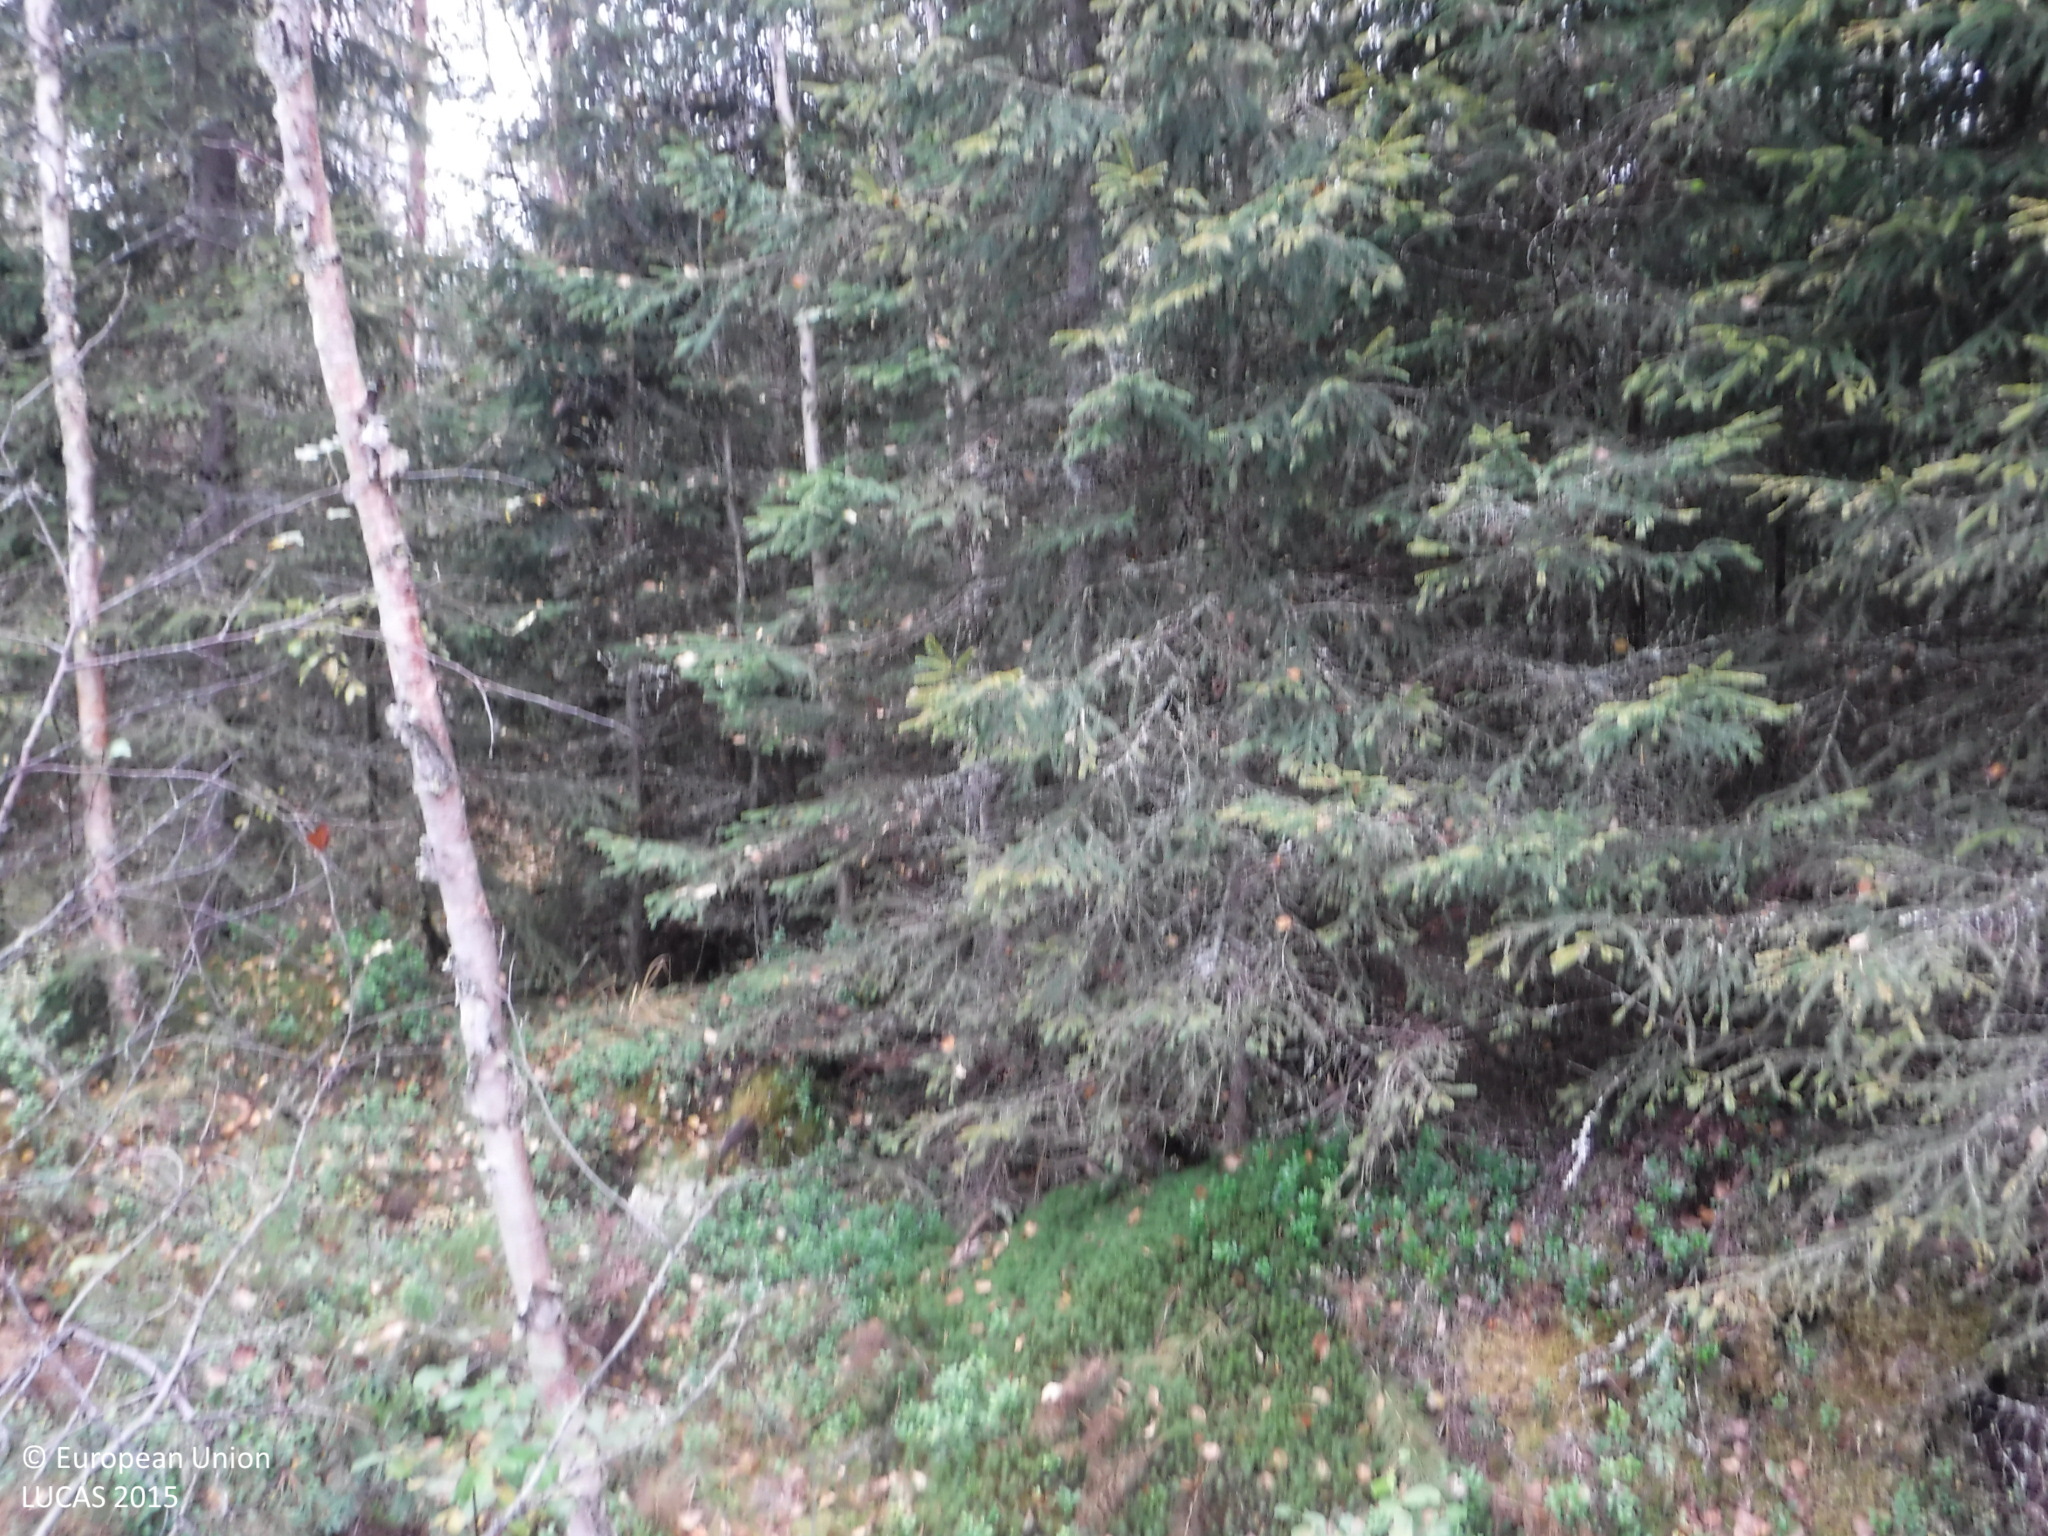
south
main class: Woodland
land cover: Other mixed woodland
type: boreal forest
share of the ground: 50 - 75 %
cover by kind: shrubs 40 %, broadleaved forest trees 30 %, coniferous forest trees 20 %, lichens and mosses 10 %
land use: Forestry
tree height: > 5 m
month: September
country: FI
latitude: 62.0280
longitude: 23.1996
